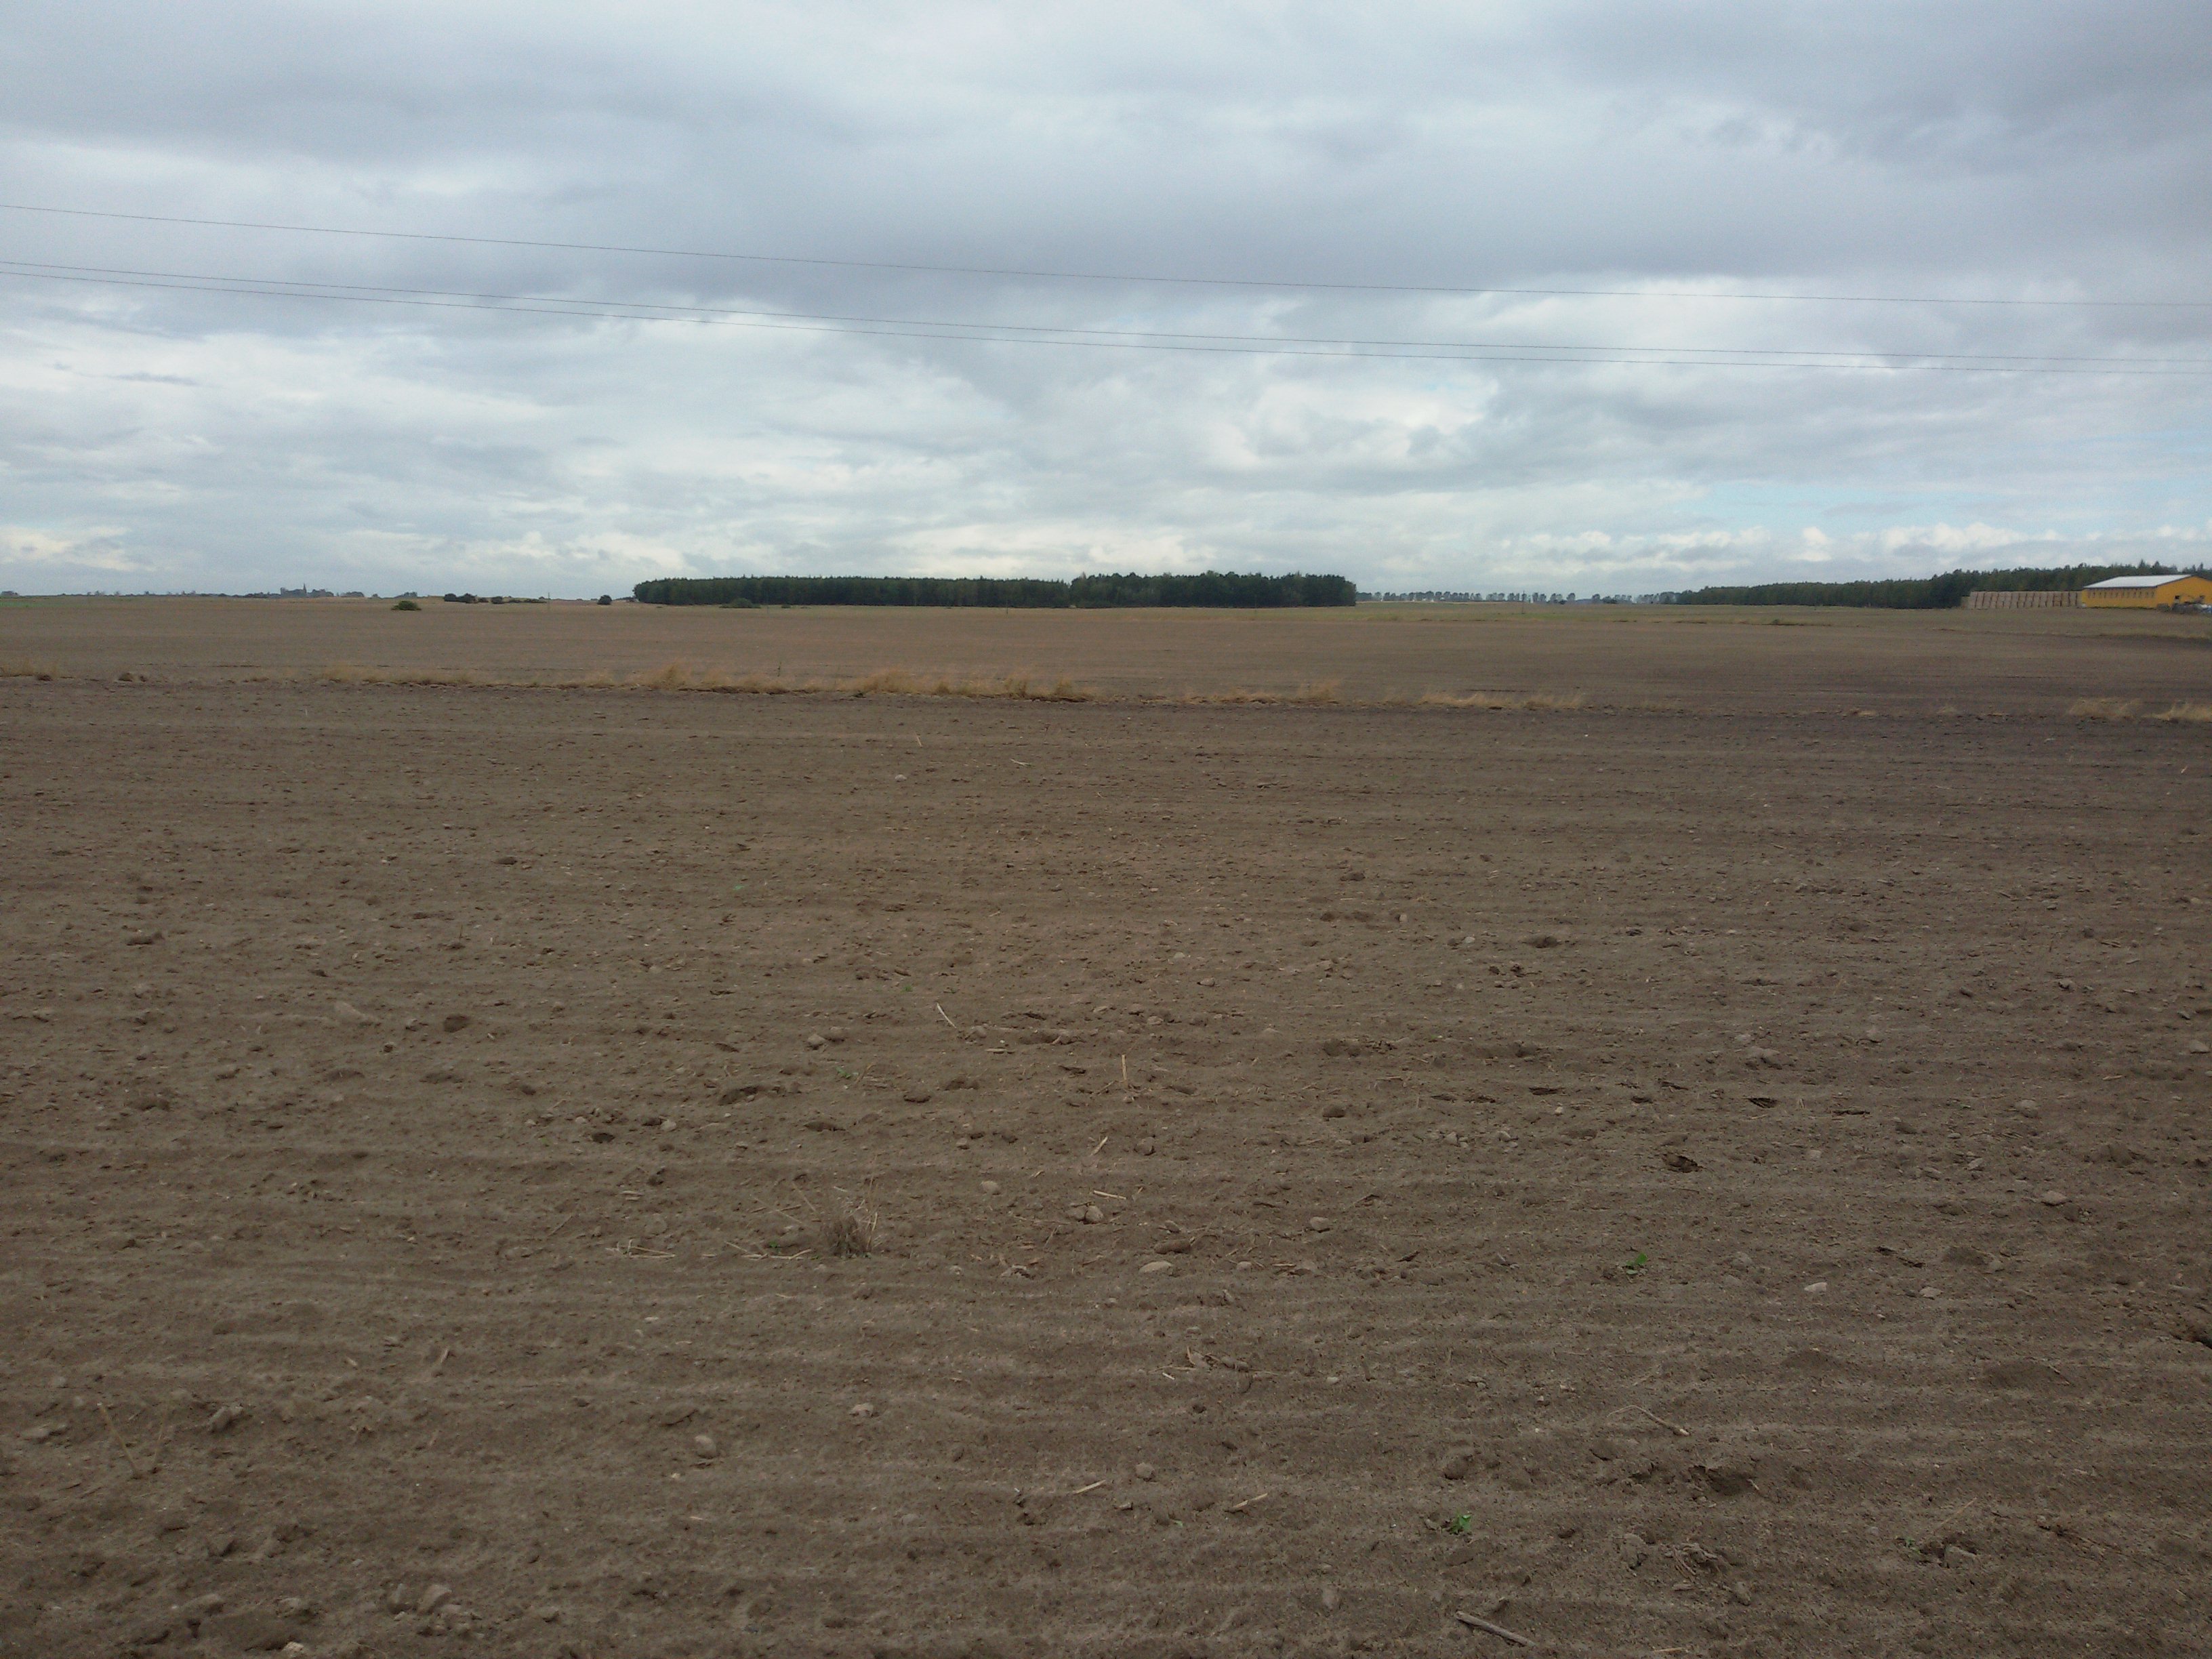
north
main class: Cropland
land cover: Rape and turnip rape
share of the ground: < 10 %
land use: Agriculture (excluding fallow land and kitchen gardens)
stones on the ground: < 10 %
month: September
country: PL
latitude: 52.7506
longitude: 17.5536
